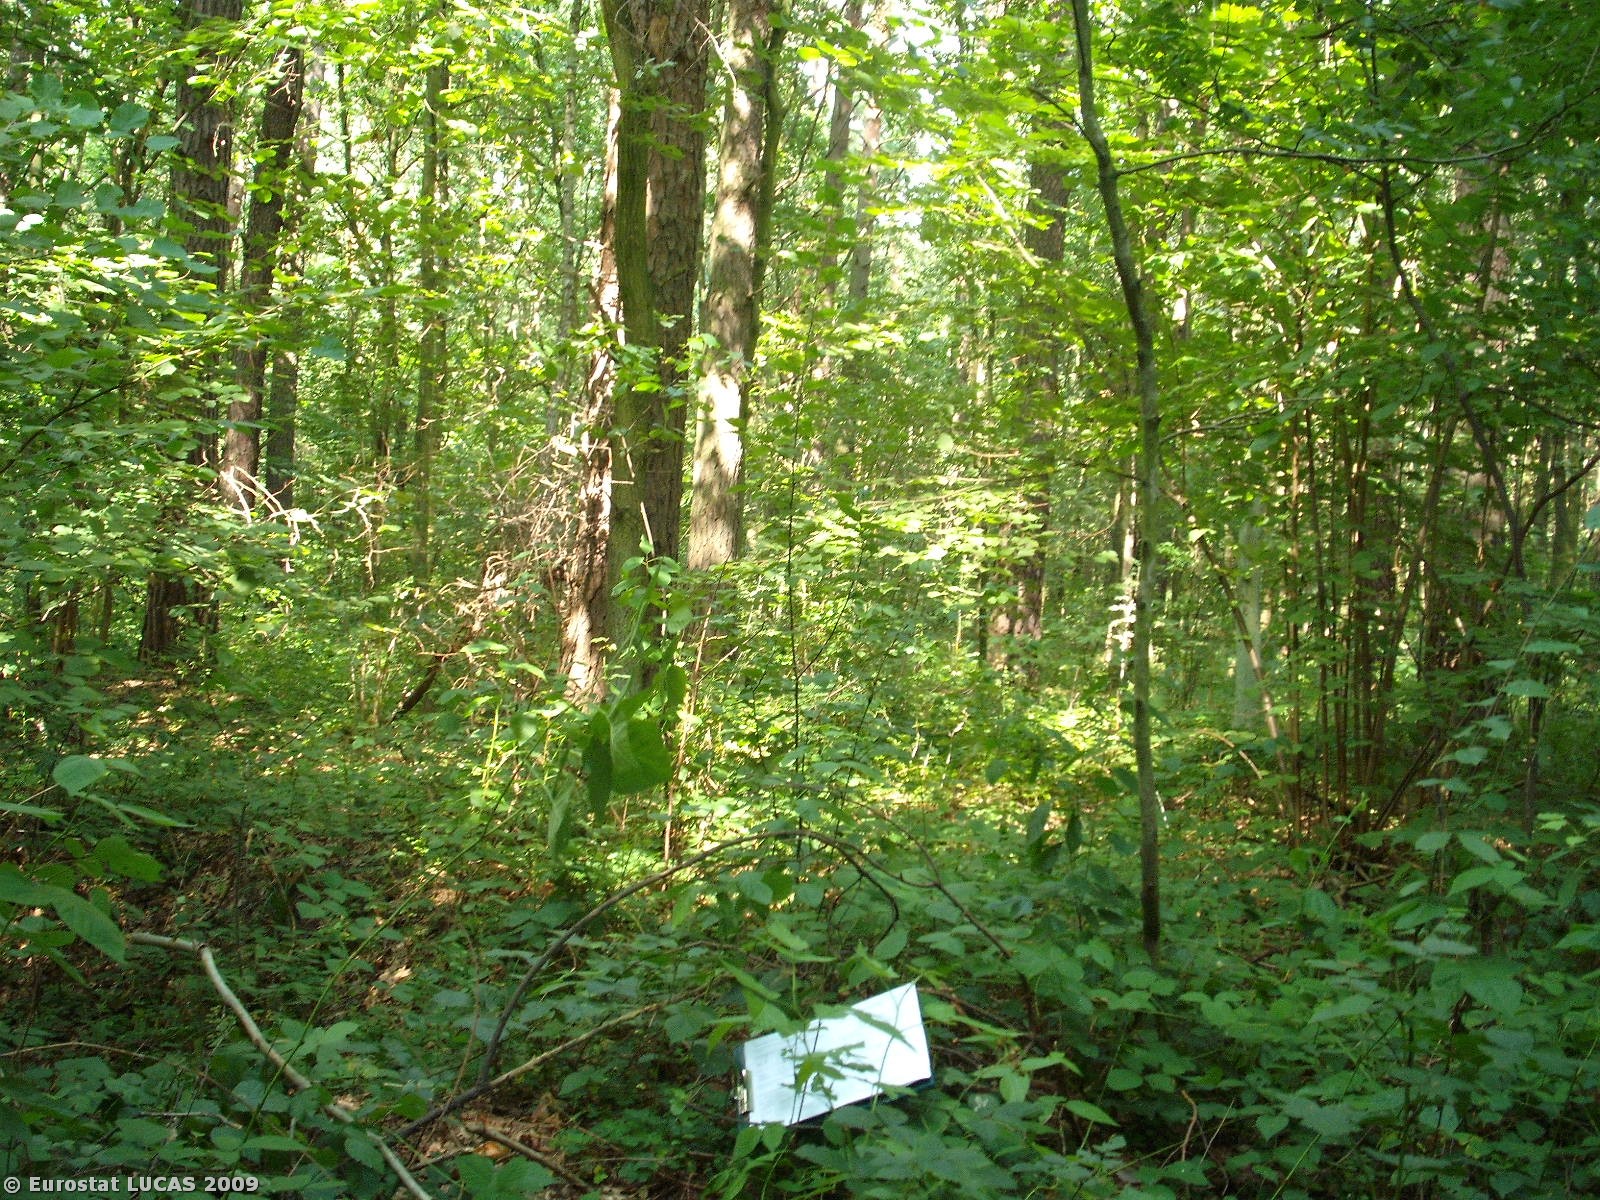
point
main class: Woodland
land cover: Mixed woodland
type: hemiboreal forest and nemoral coniferous forest and mixed broadleaved-coniferous forest
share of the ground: > 75 %
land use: Forestry
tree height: > 5 m
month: August
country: PL
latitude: 51.8111
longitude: 21.5542
